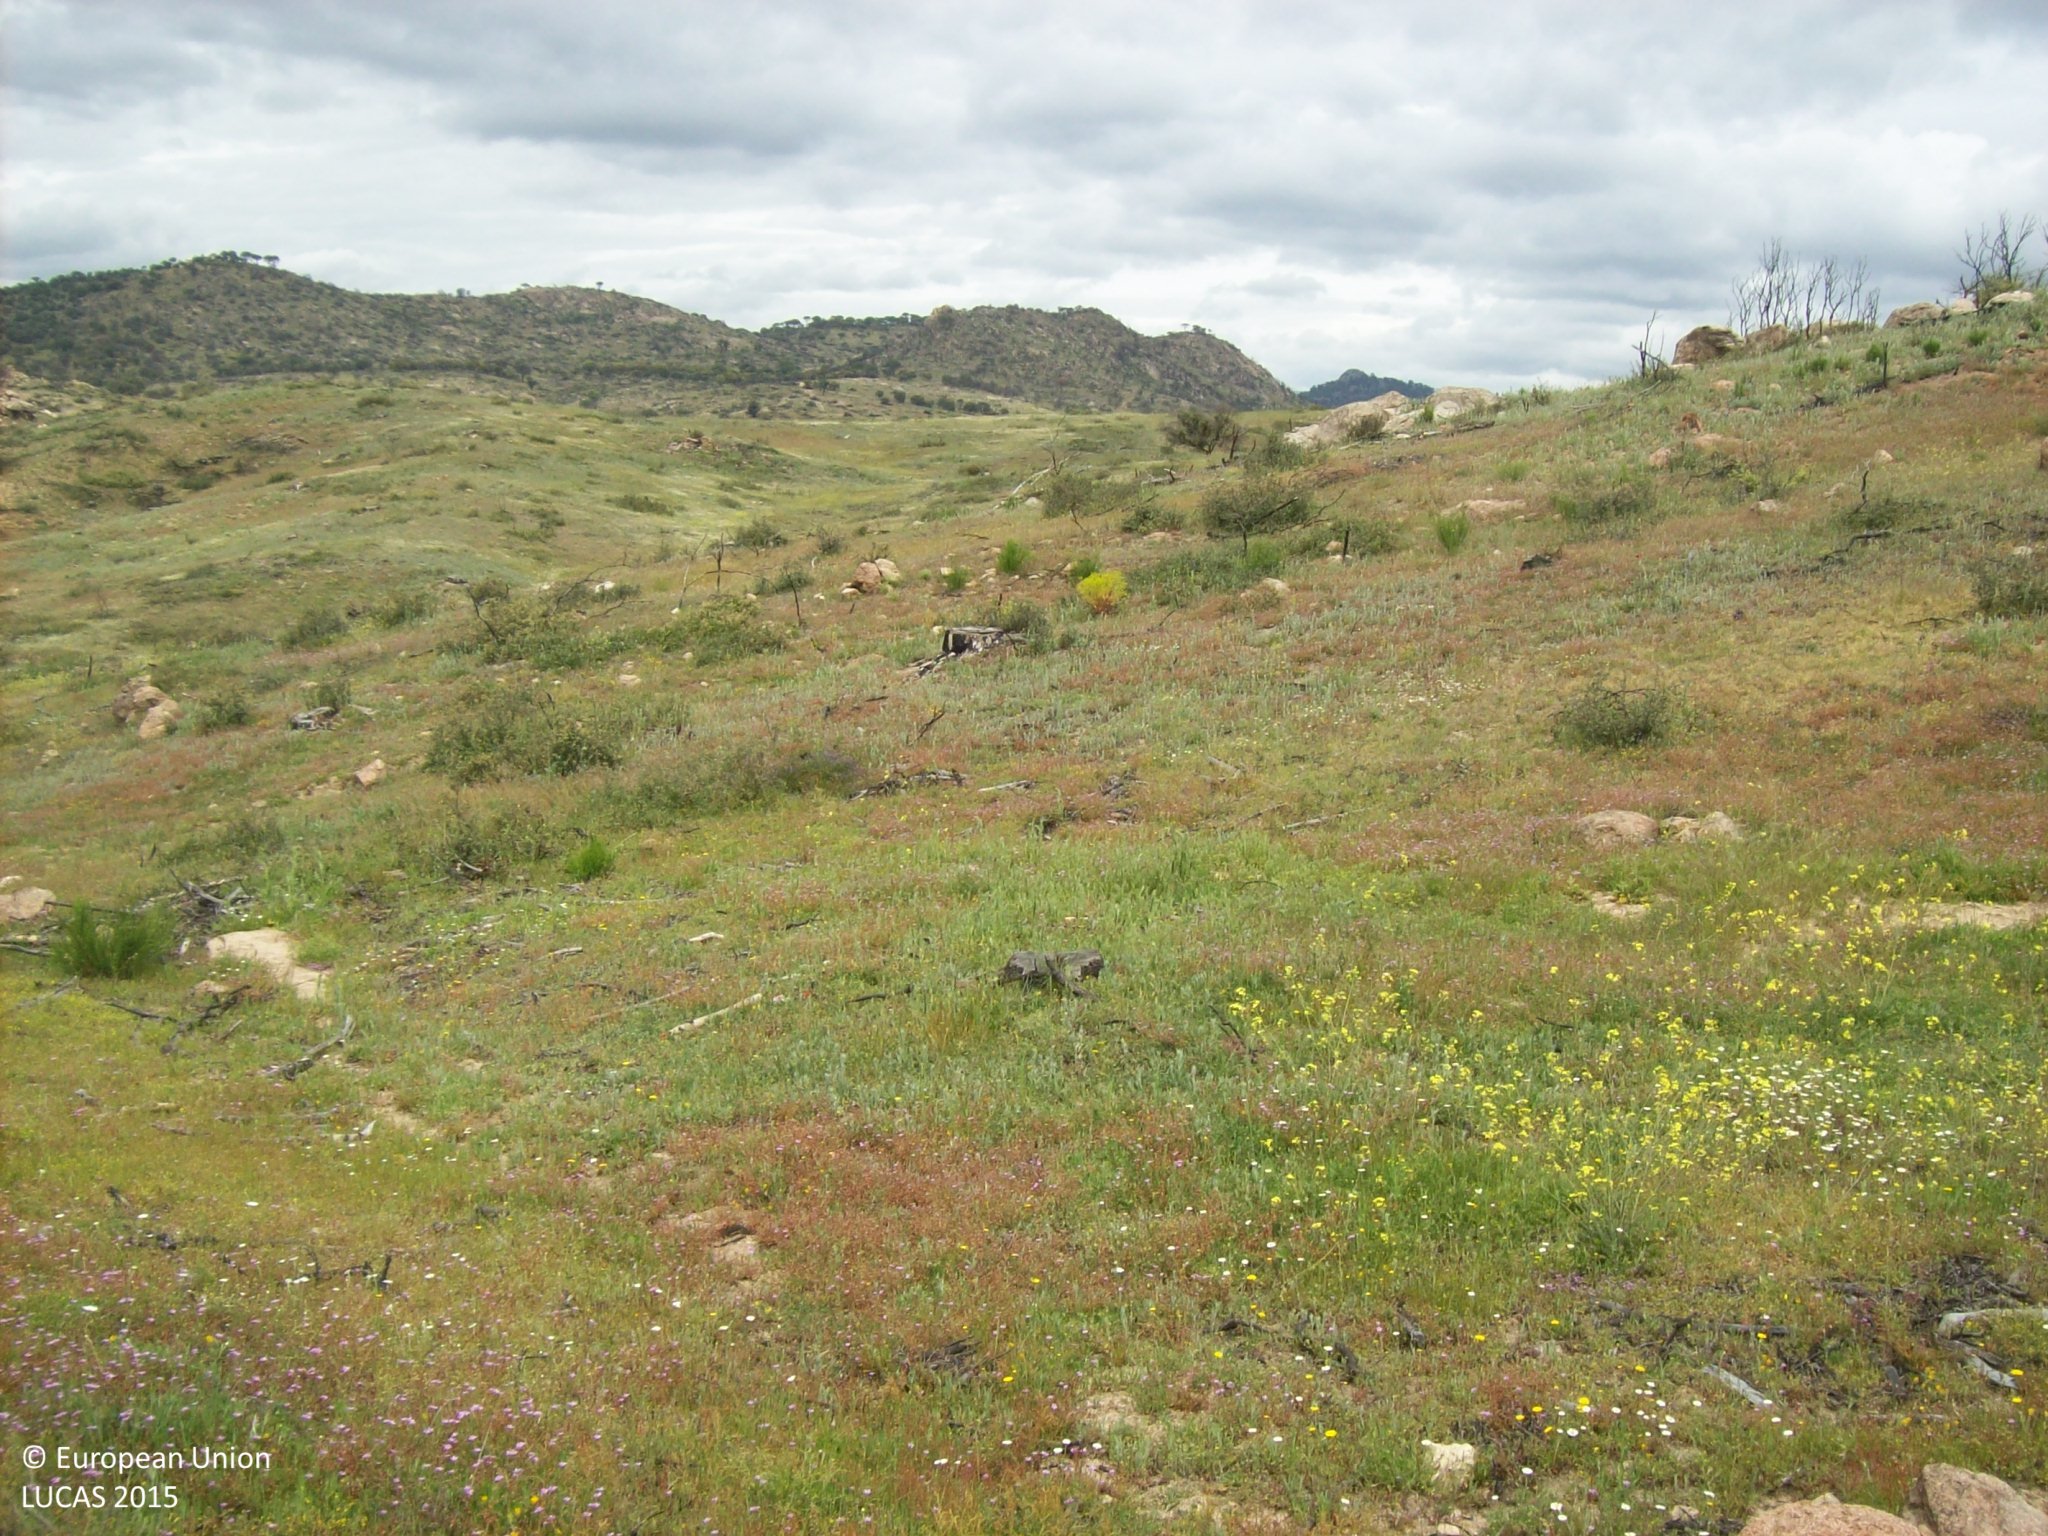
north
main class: Grassland
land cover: Grassland without tree/shrub cover
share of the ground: > 75 %
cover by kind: herbaceous plants 100 %
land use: Semi-natural and natural areas not in use
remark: Burnt area
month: April
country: ES
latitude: 40.4500
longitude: -4.3736
